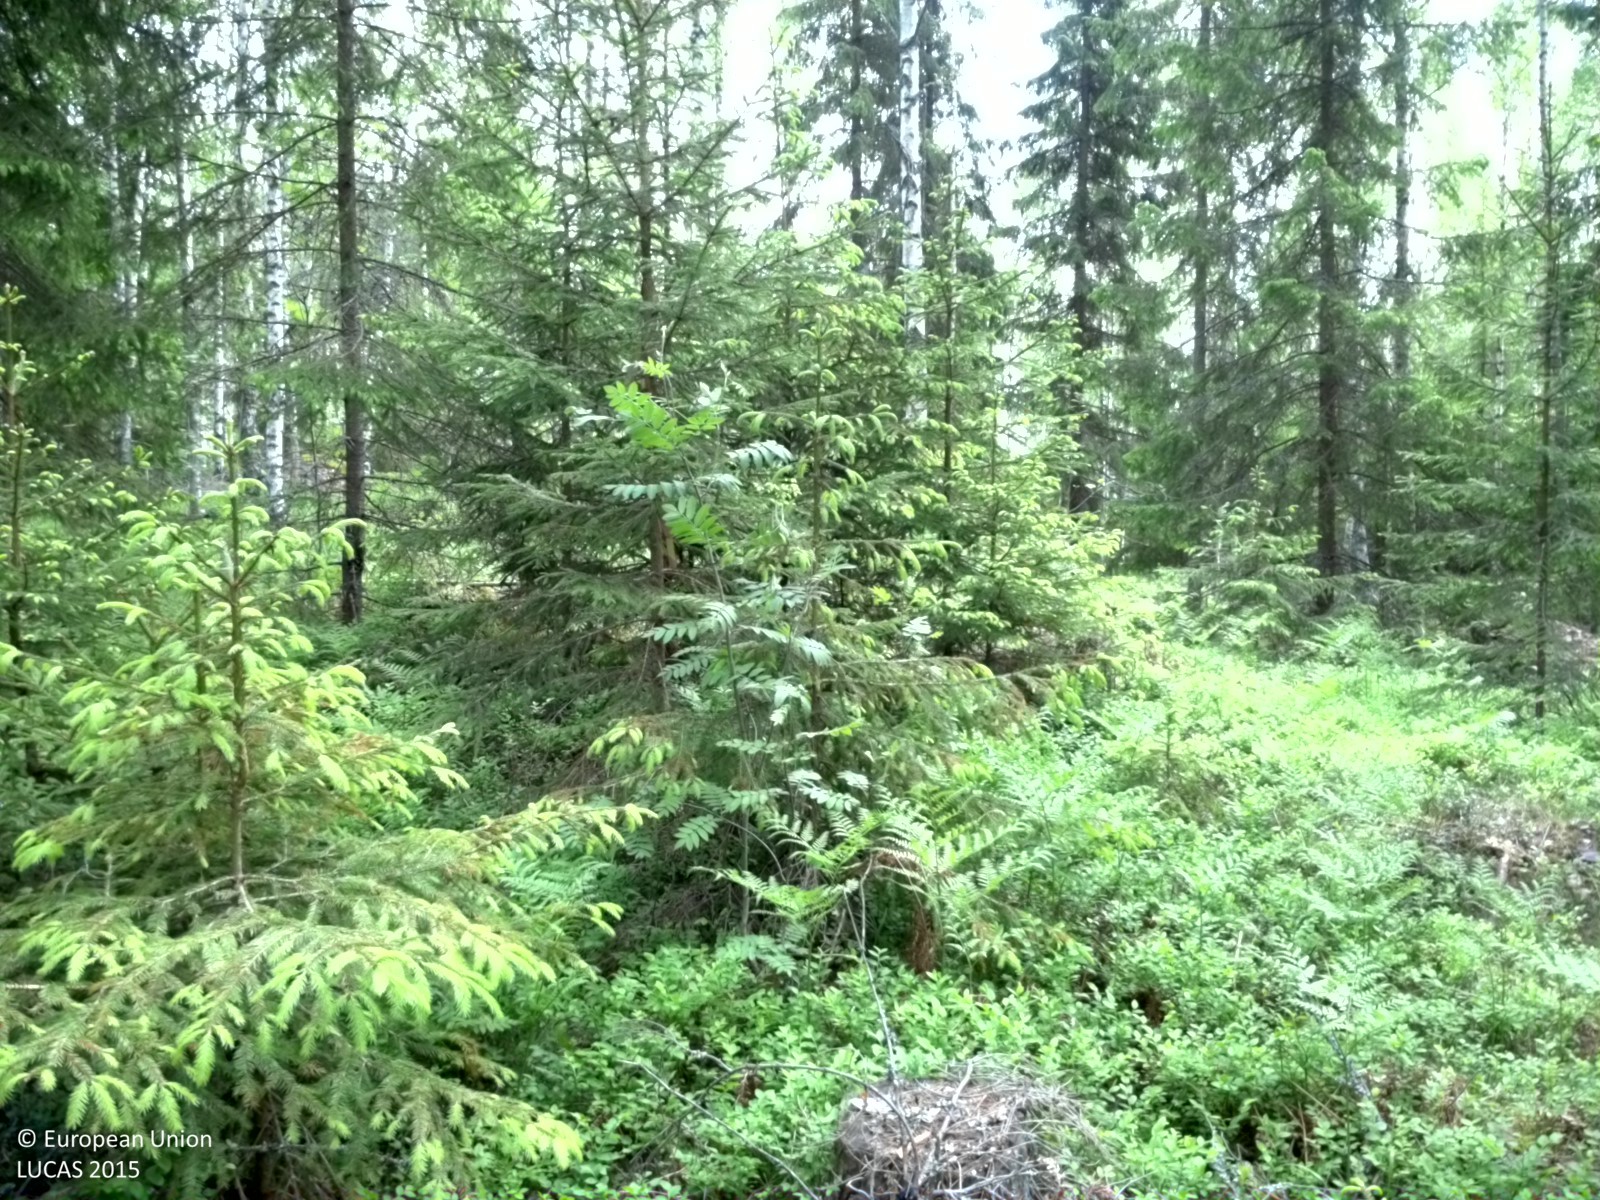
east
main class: Woodland
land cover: Other coniferous woodland
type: boreal forest
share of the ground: 50 - 75 %
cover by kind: coniferous forest trees 50 %, broadleaved forest trees 15 %, shrubs 15 %, herbaceous plants 5 %, lichens and mosses 5 %, consolidated bare surface 5 %
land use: Forestry
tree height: > 5 m
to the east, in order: Other coniferous woodland; Broadleaved woodland; Pine dominated mixed woodland; Tracks; Broadleaved woodland; Tracks; Electric lines; Broadleaved woodland; Electric lines; Grassland with sparse tree/shrub cover; Broadleaved woodland; Ditches and canals; Broadleaved woodland; Grassland without tree/shrub cover; Ditches and canals; Grassland without tree/shrub cover; Fences; Grassland without tree/shrub cover
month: June
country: SE
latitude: 60.3287
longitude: 17.0715
